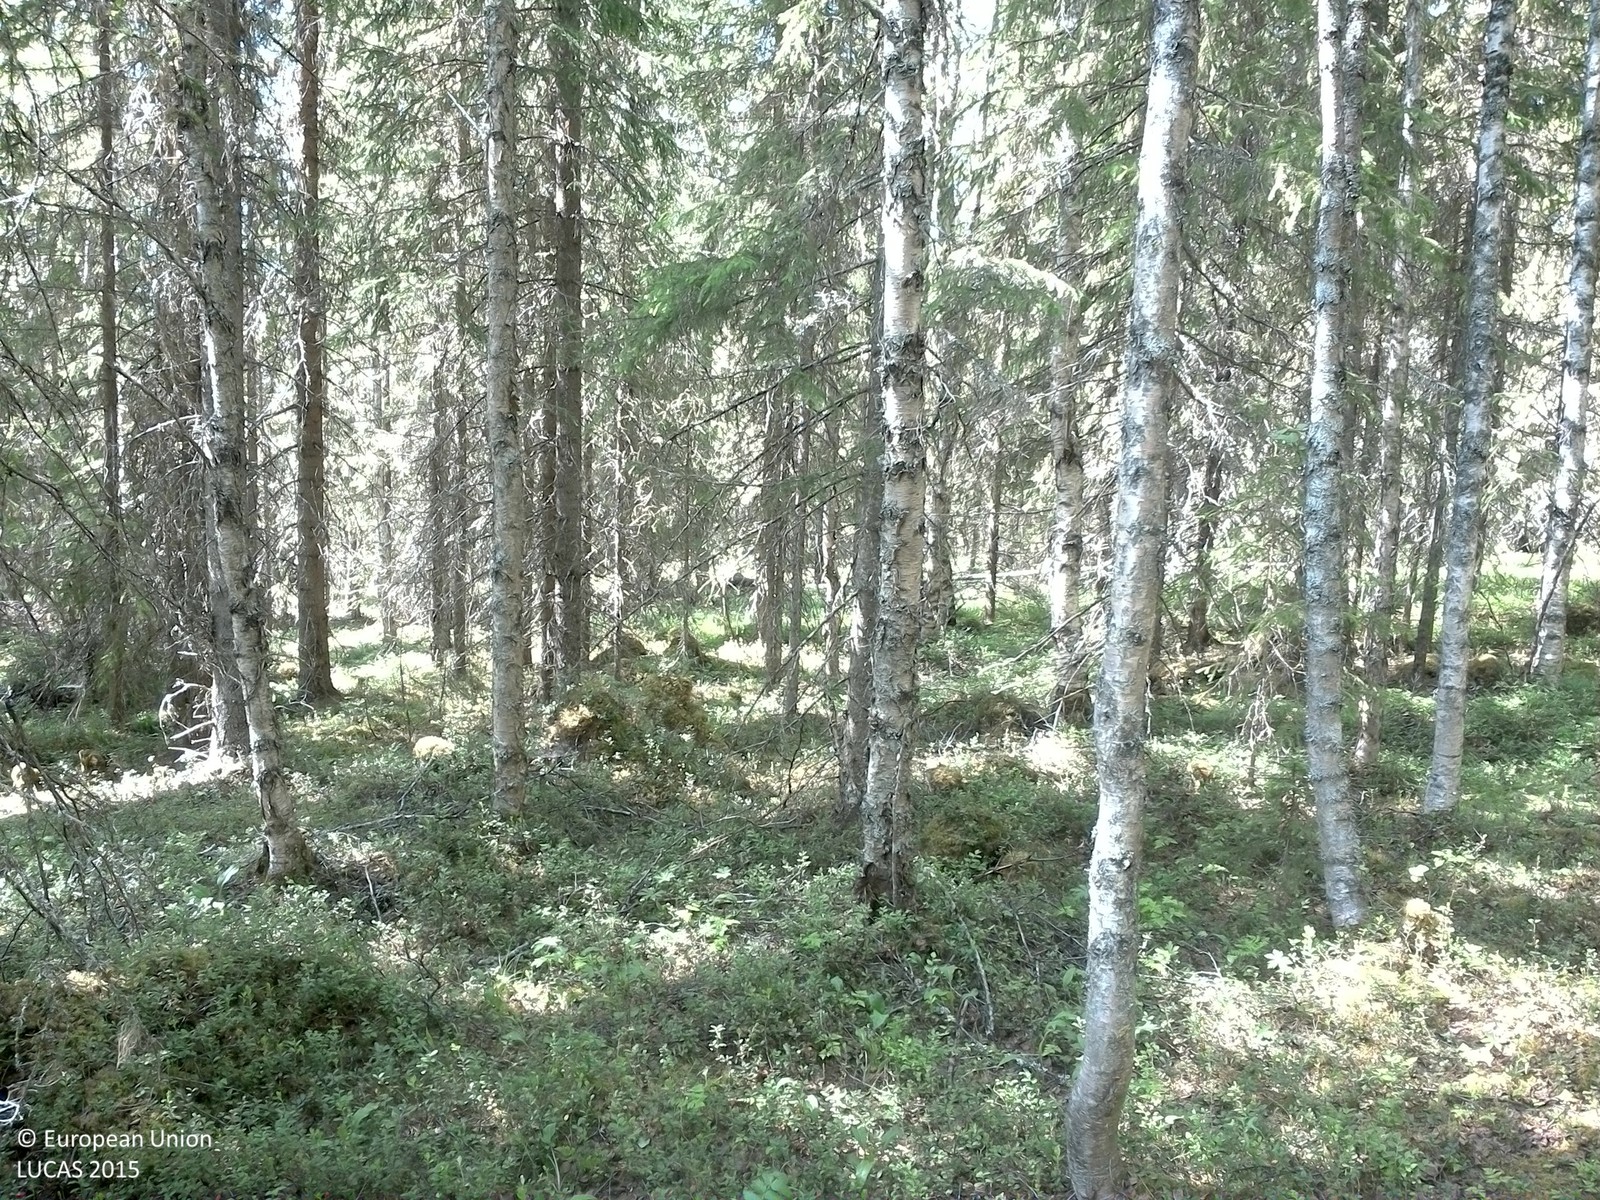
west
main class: Woodland
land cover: Spruce dominated mixed woodland
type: boreal forest
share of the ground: 50 - 75 %
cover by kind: coniferous forest trees 55 %, broadleaved forest trees 20 %, shrubs 15 %, herbaceous plants 5 %, lichens and mosses 5 %
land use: Forestry
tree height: > 5 m
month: July
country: SE
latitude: 64.2542
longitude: 16.7575
